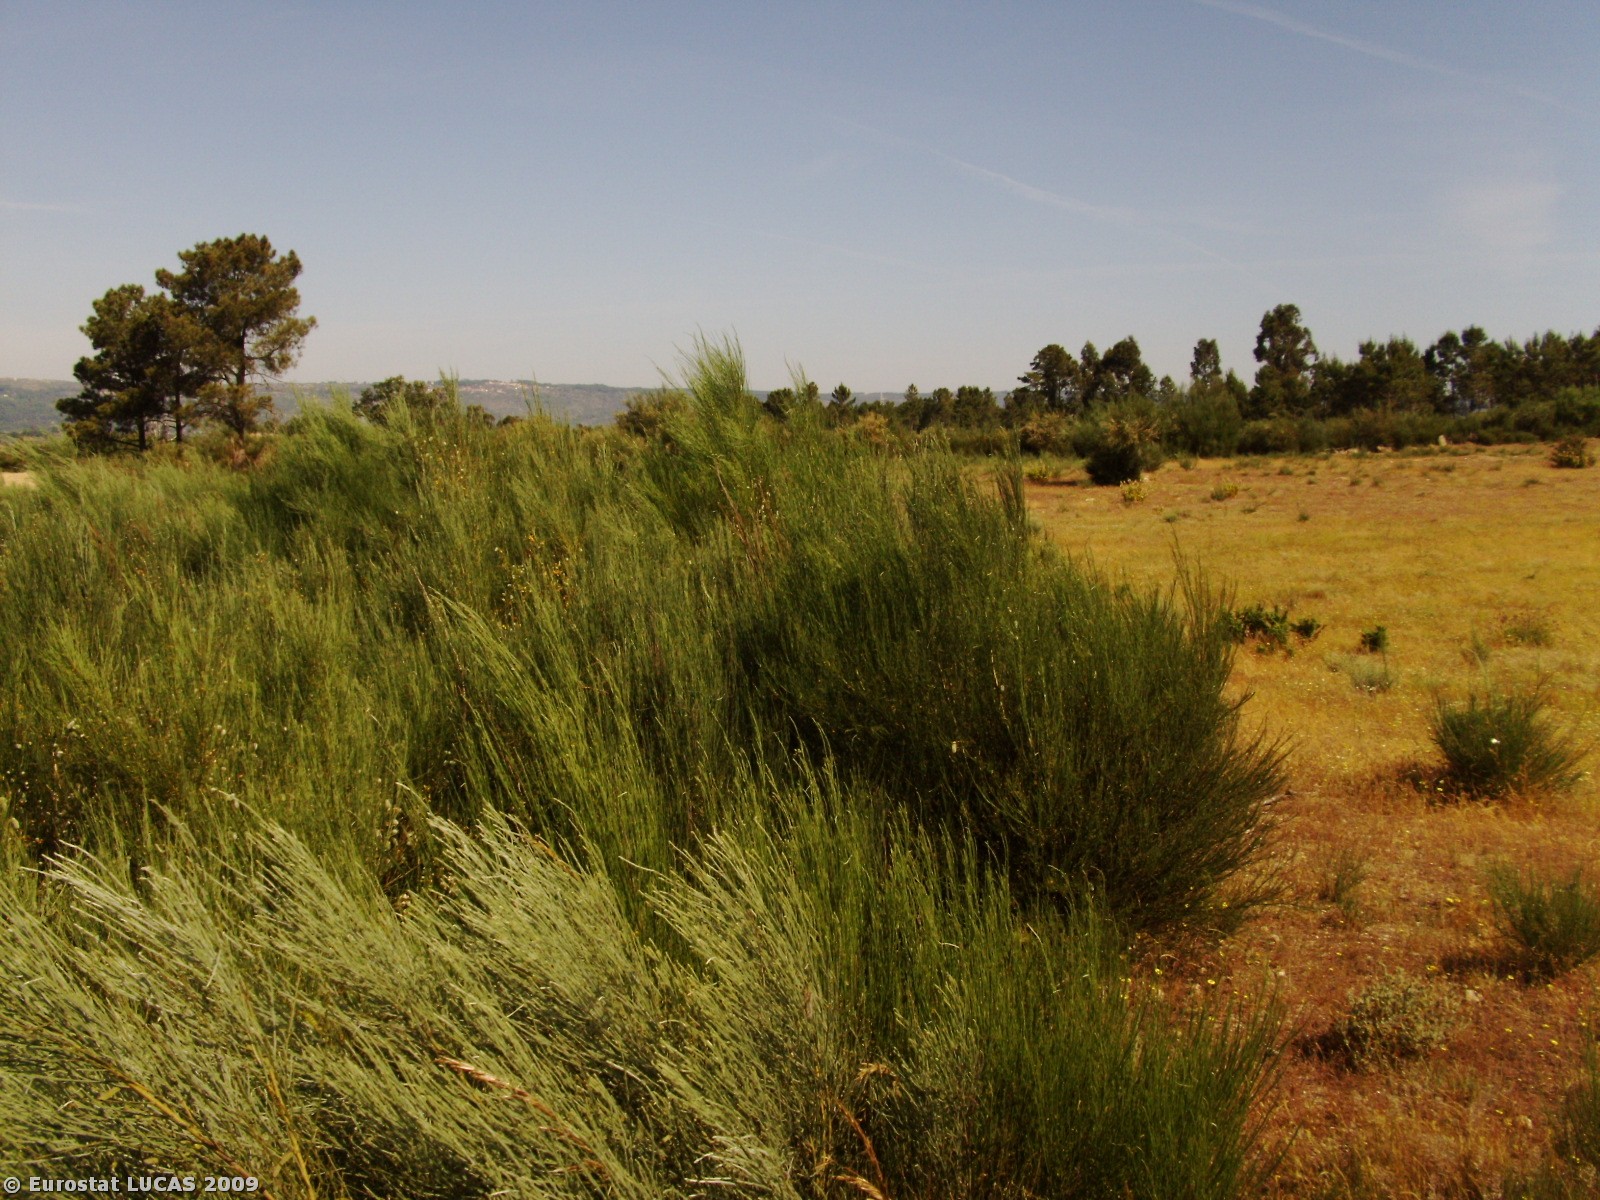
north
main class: Shrubland
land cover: Shrubland without tree cover
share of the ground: > 75 %
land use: Unused
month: June
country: PT
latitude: 40.5873
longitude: -7.4680
